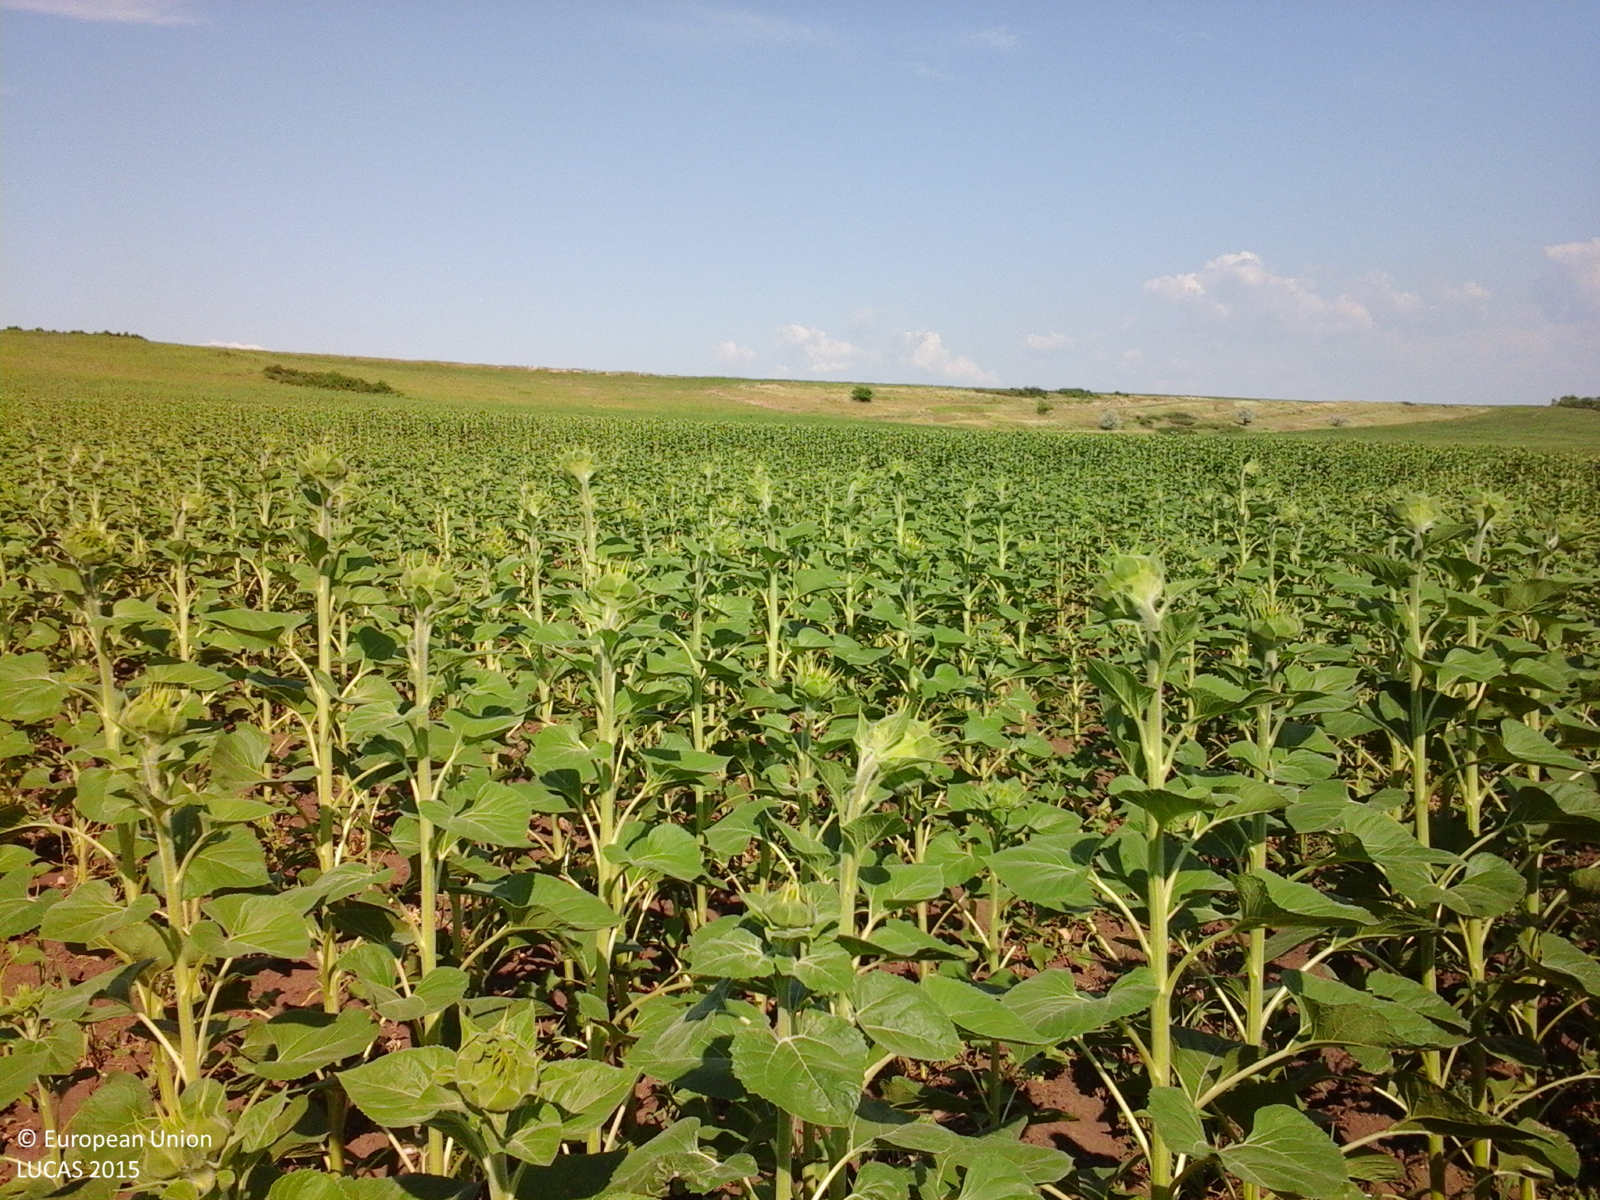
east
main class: Cropland
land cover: Sunflower
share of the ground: 50 - 75 %
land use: Agriculture (excluding fallow land and kitchen gardens)
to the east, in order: Sunflower
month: June
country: RO
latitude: 46.8837
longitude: 28.0435
